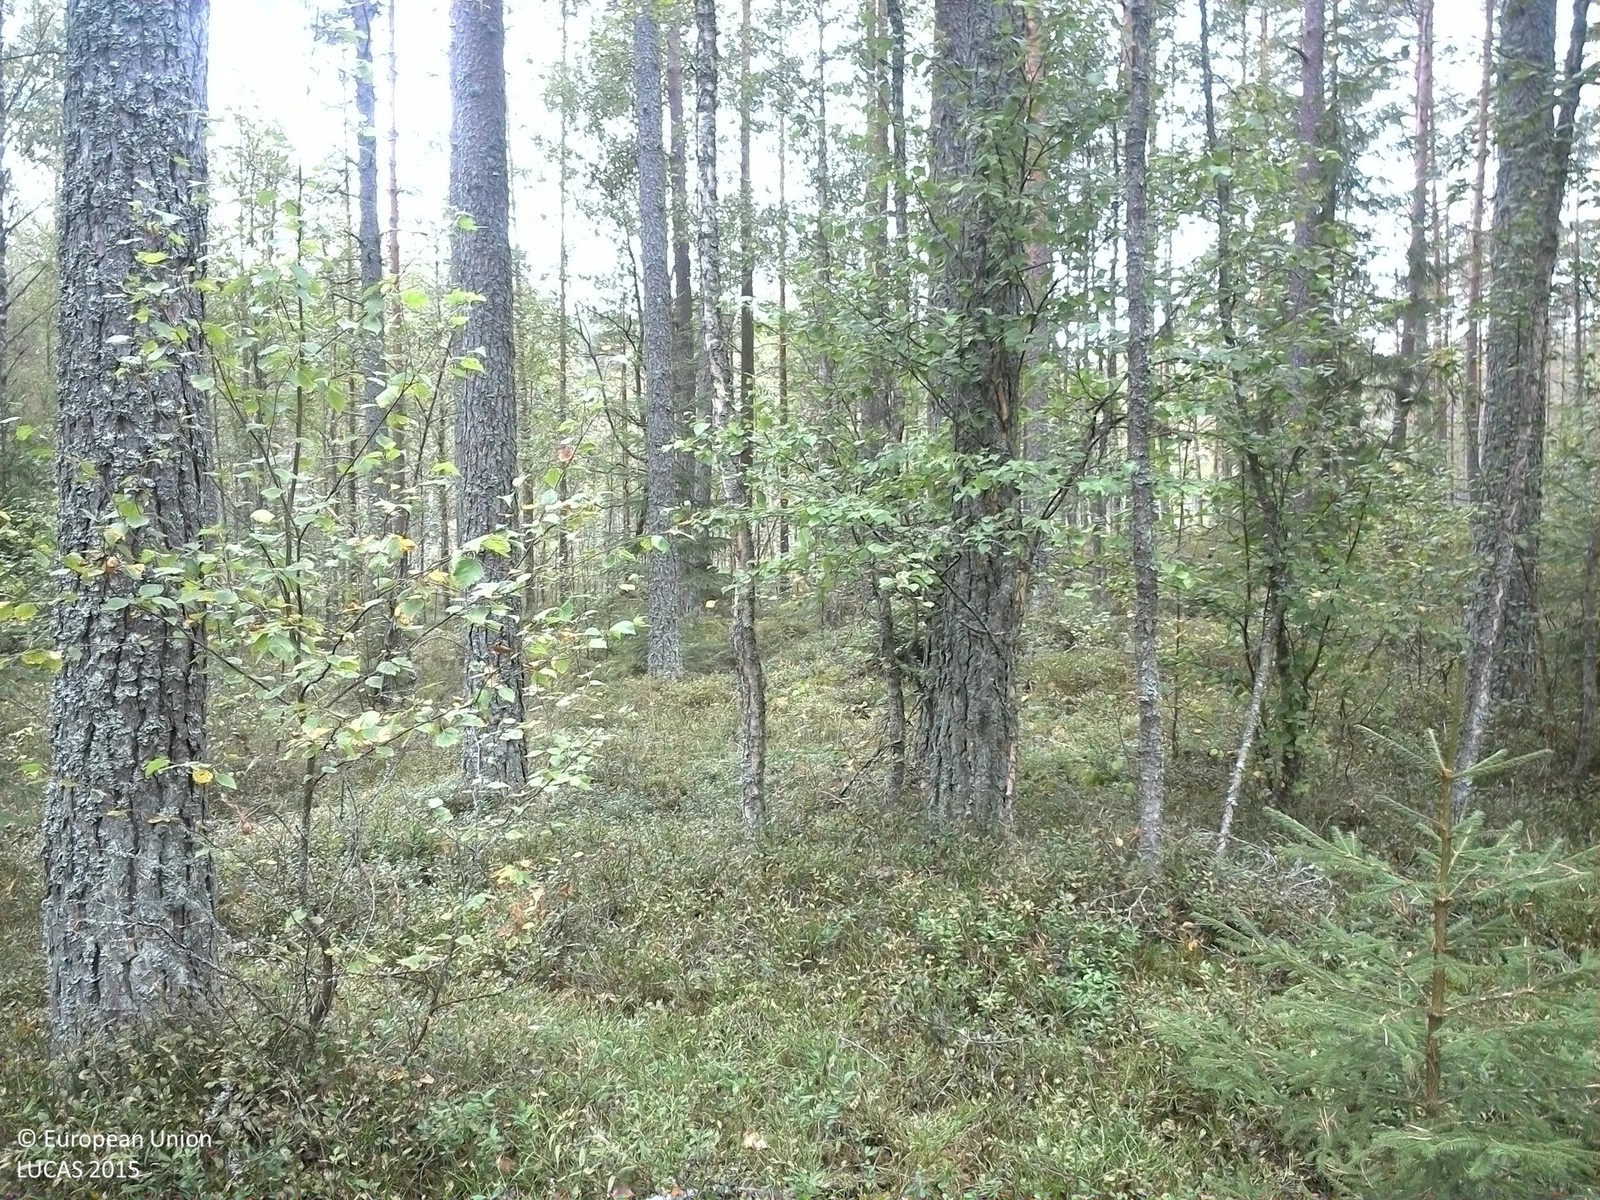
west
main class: Woodland
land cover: Pine dominated coniferous woodland
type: boreal forest
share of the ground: 50 - 75 %
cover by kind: coniferous forest trees 70 %, shrubs 20 %, broadleaved forest trees 5 %, lichens and mosses 5 %
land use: Forestry
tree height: > 5 m
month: September
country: SE
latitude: 59.7418
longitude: 13.4608
